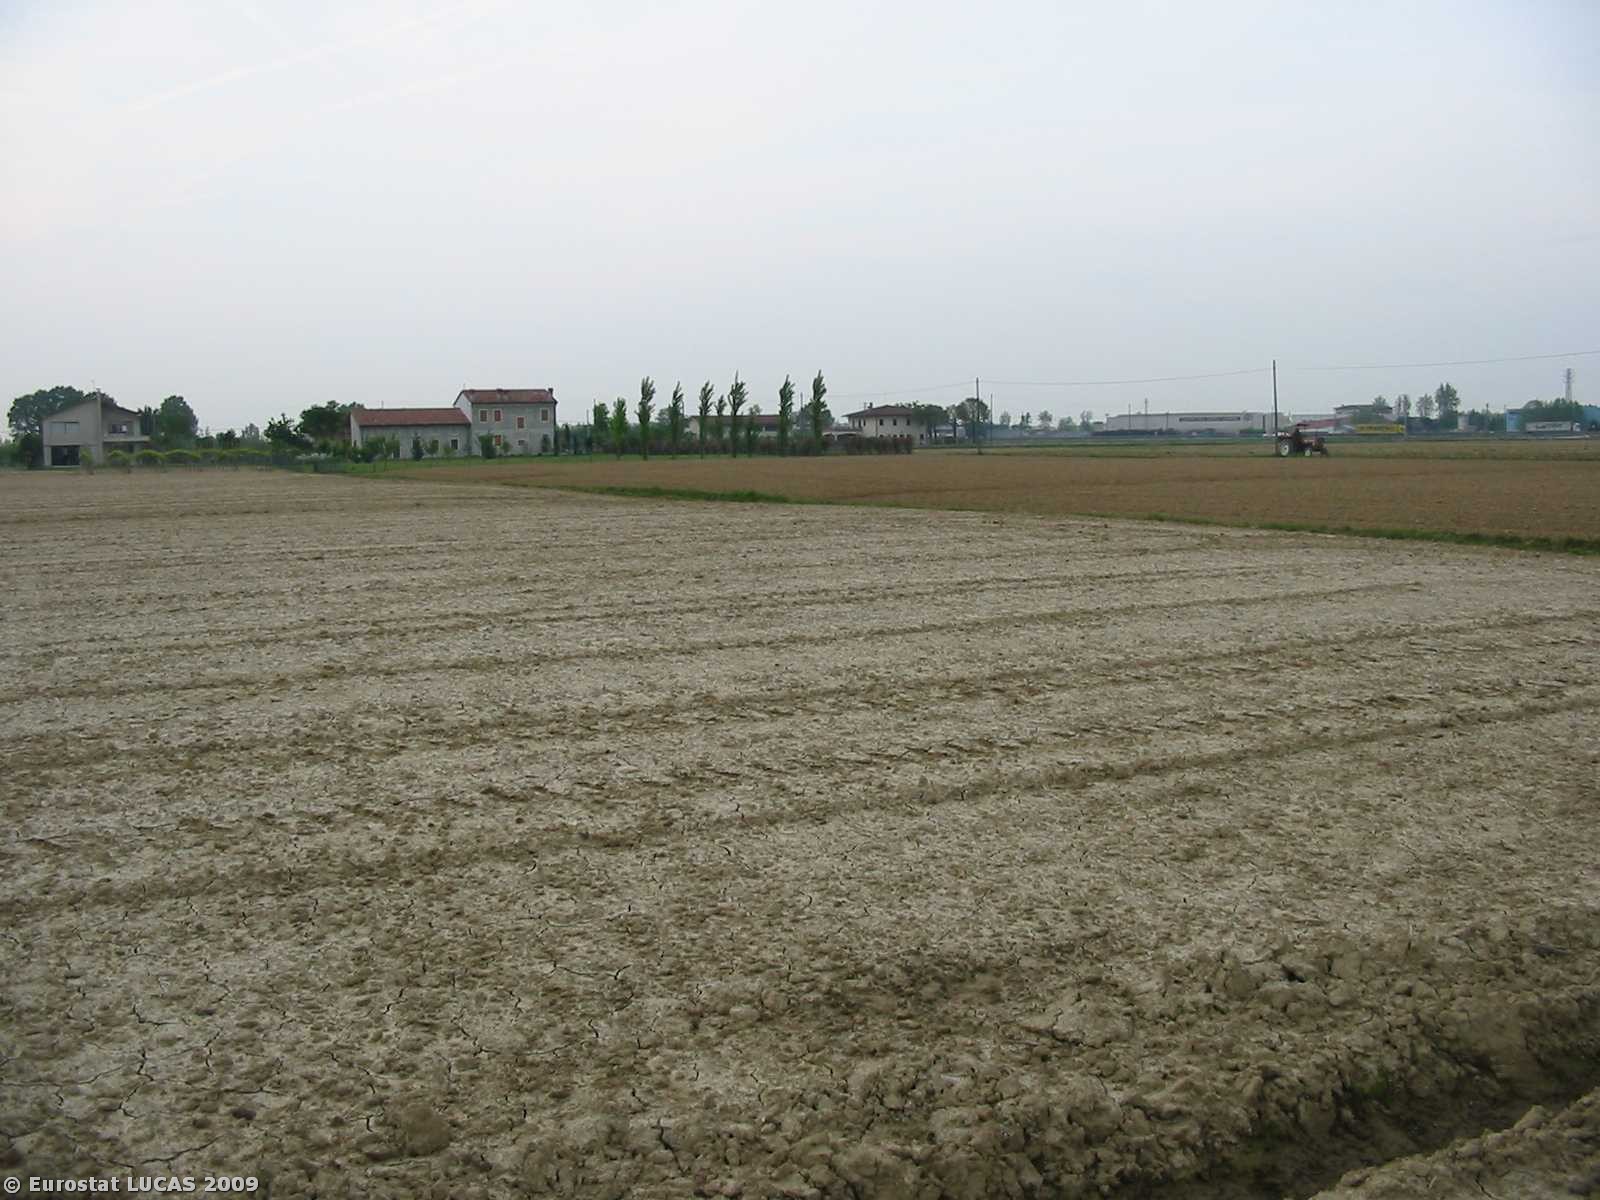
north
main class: Cropland
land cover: Maize
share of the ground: < 10 %
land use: Agriculture (excluding fallow land and kitchen gardens)
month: May
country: IT
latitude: 45.4915
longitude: 11.6479
